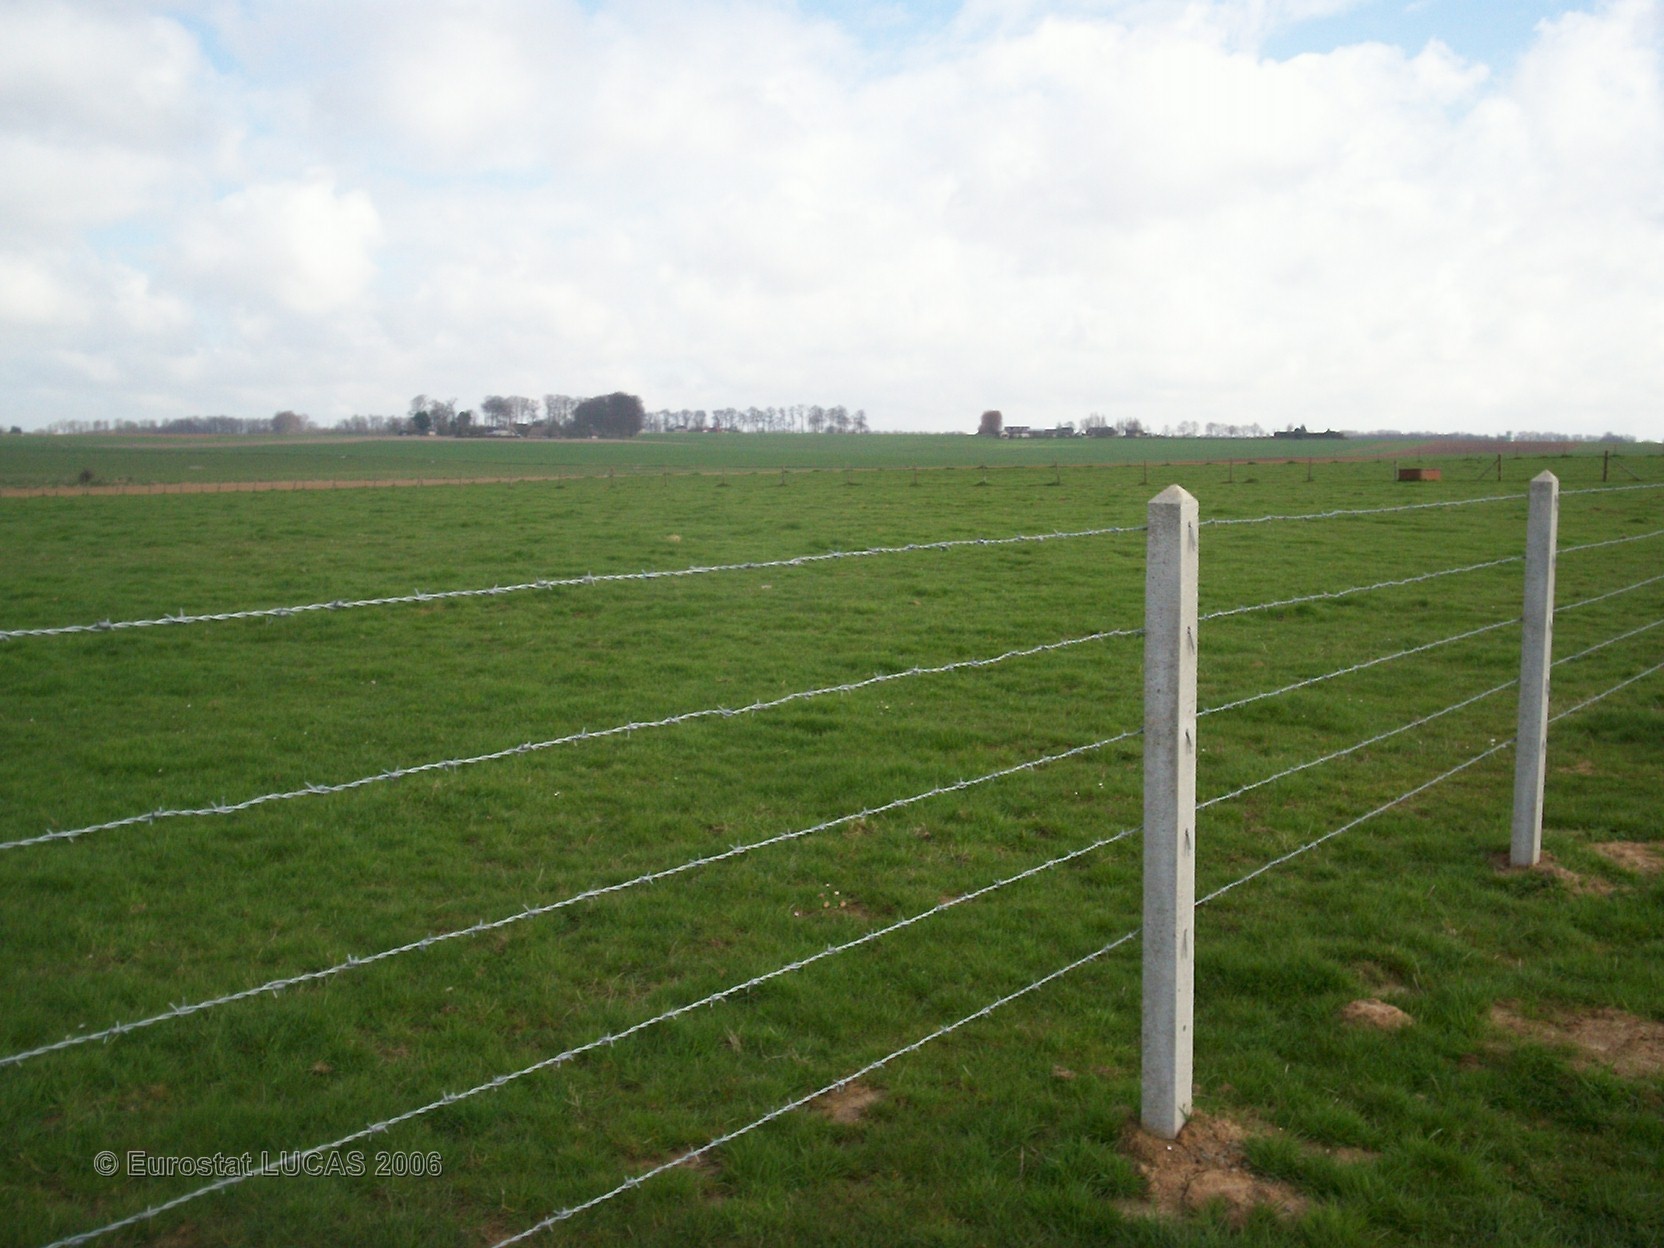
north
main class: Grassland
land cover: Grassland without tree/shrub cover
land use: Agriculture (excluding fallow land and kitchen gardens)
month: April
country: FR
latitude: 49.5679
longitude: 0.9201
